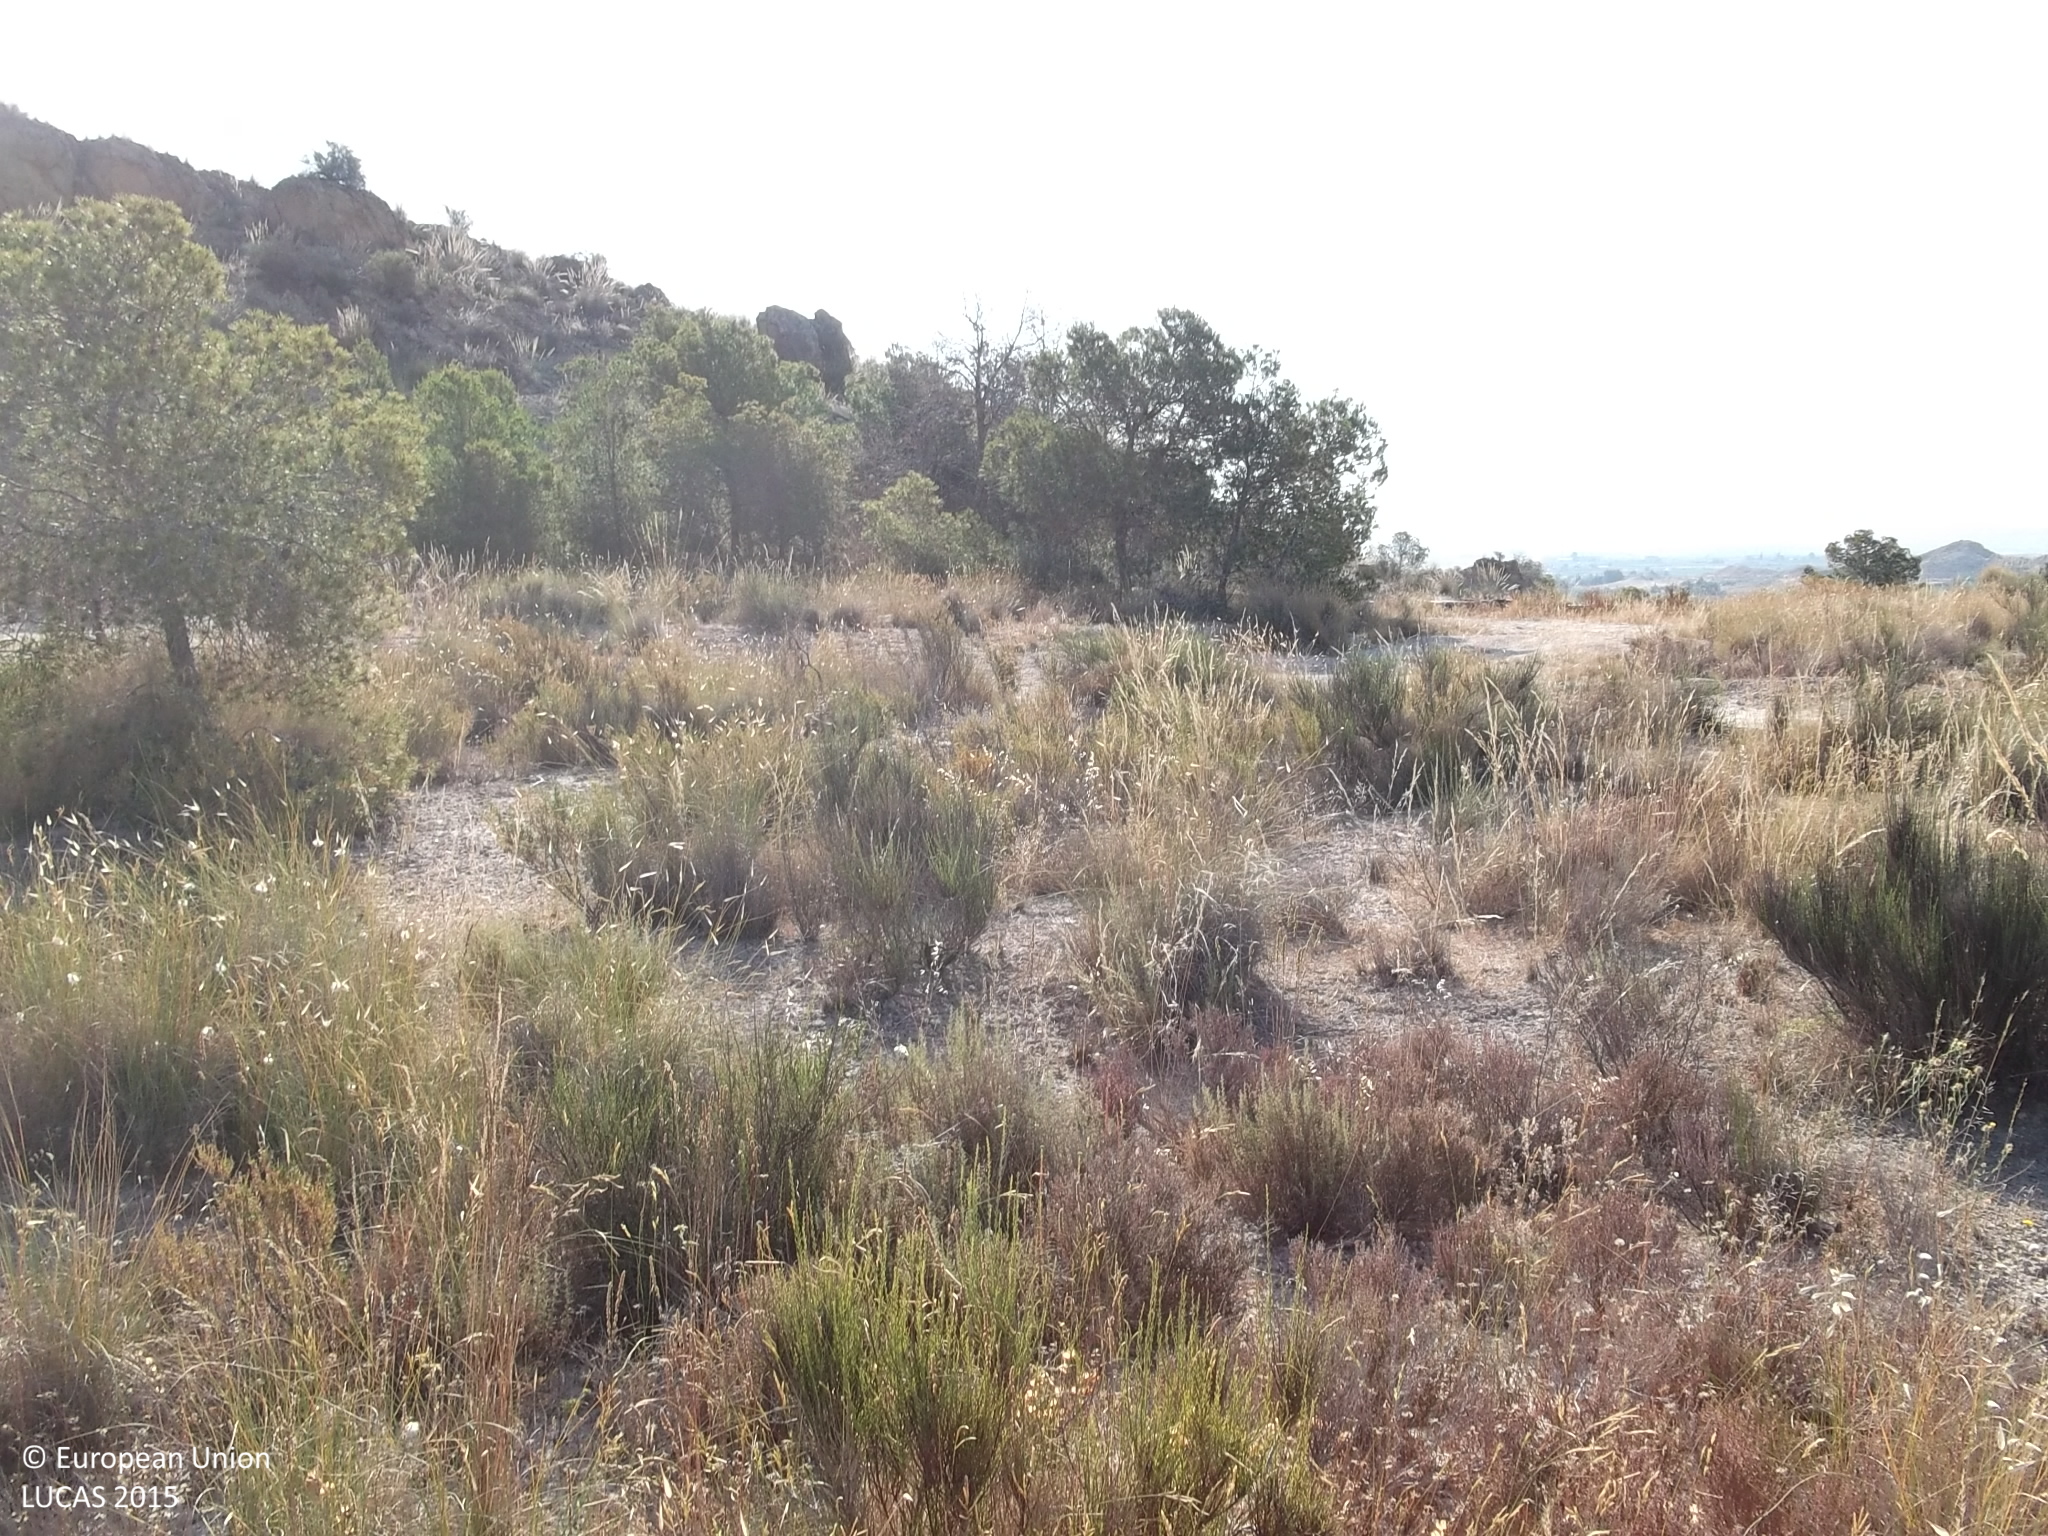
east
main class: Woodland
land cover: Pine dominated coniferous woodland
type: coniferous forest of the mediterranean region
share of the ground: 10 - 25 %
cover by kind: shrubs 30 %, herbaceous plants 30 %, consolidated bare surface 30 %, coniferous forest trees 10 %
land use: Semi-natural and natural areas not in use
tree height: < 5 m
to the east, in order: Pine dominated coniferous woodland; Tracks; Pine dominated coniferous woodland
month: May
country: ES
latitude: 38.1335
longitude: -1.2924
